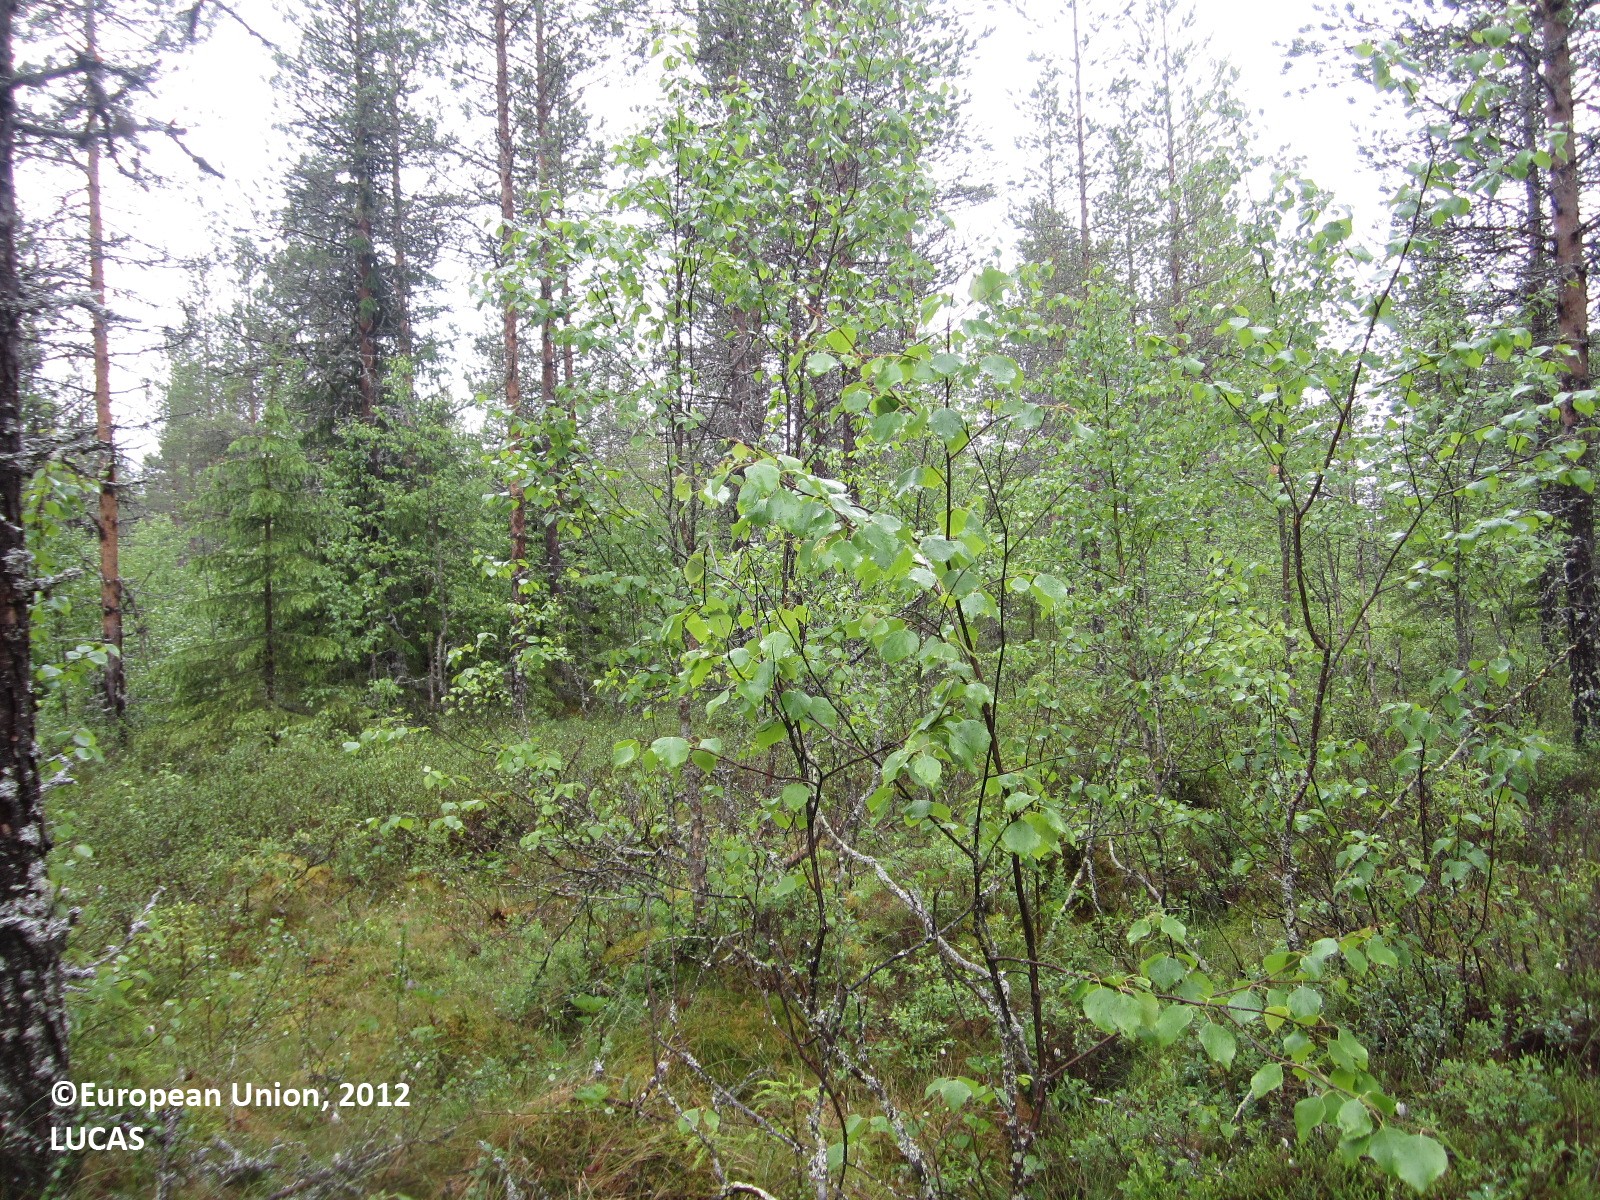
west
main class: Woodland
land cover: Pine dominated mixed woodland
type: boreal forest
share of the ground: 50 - 75 %
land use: Forestry
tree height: > 5 m
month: June
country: FI
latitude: 64.6151
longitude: 29.7701
